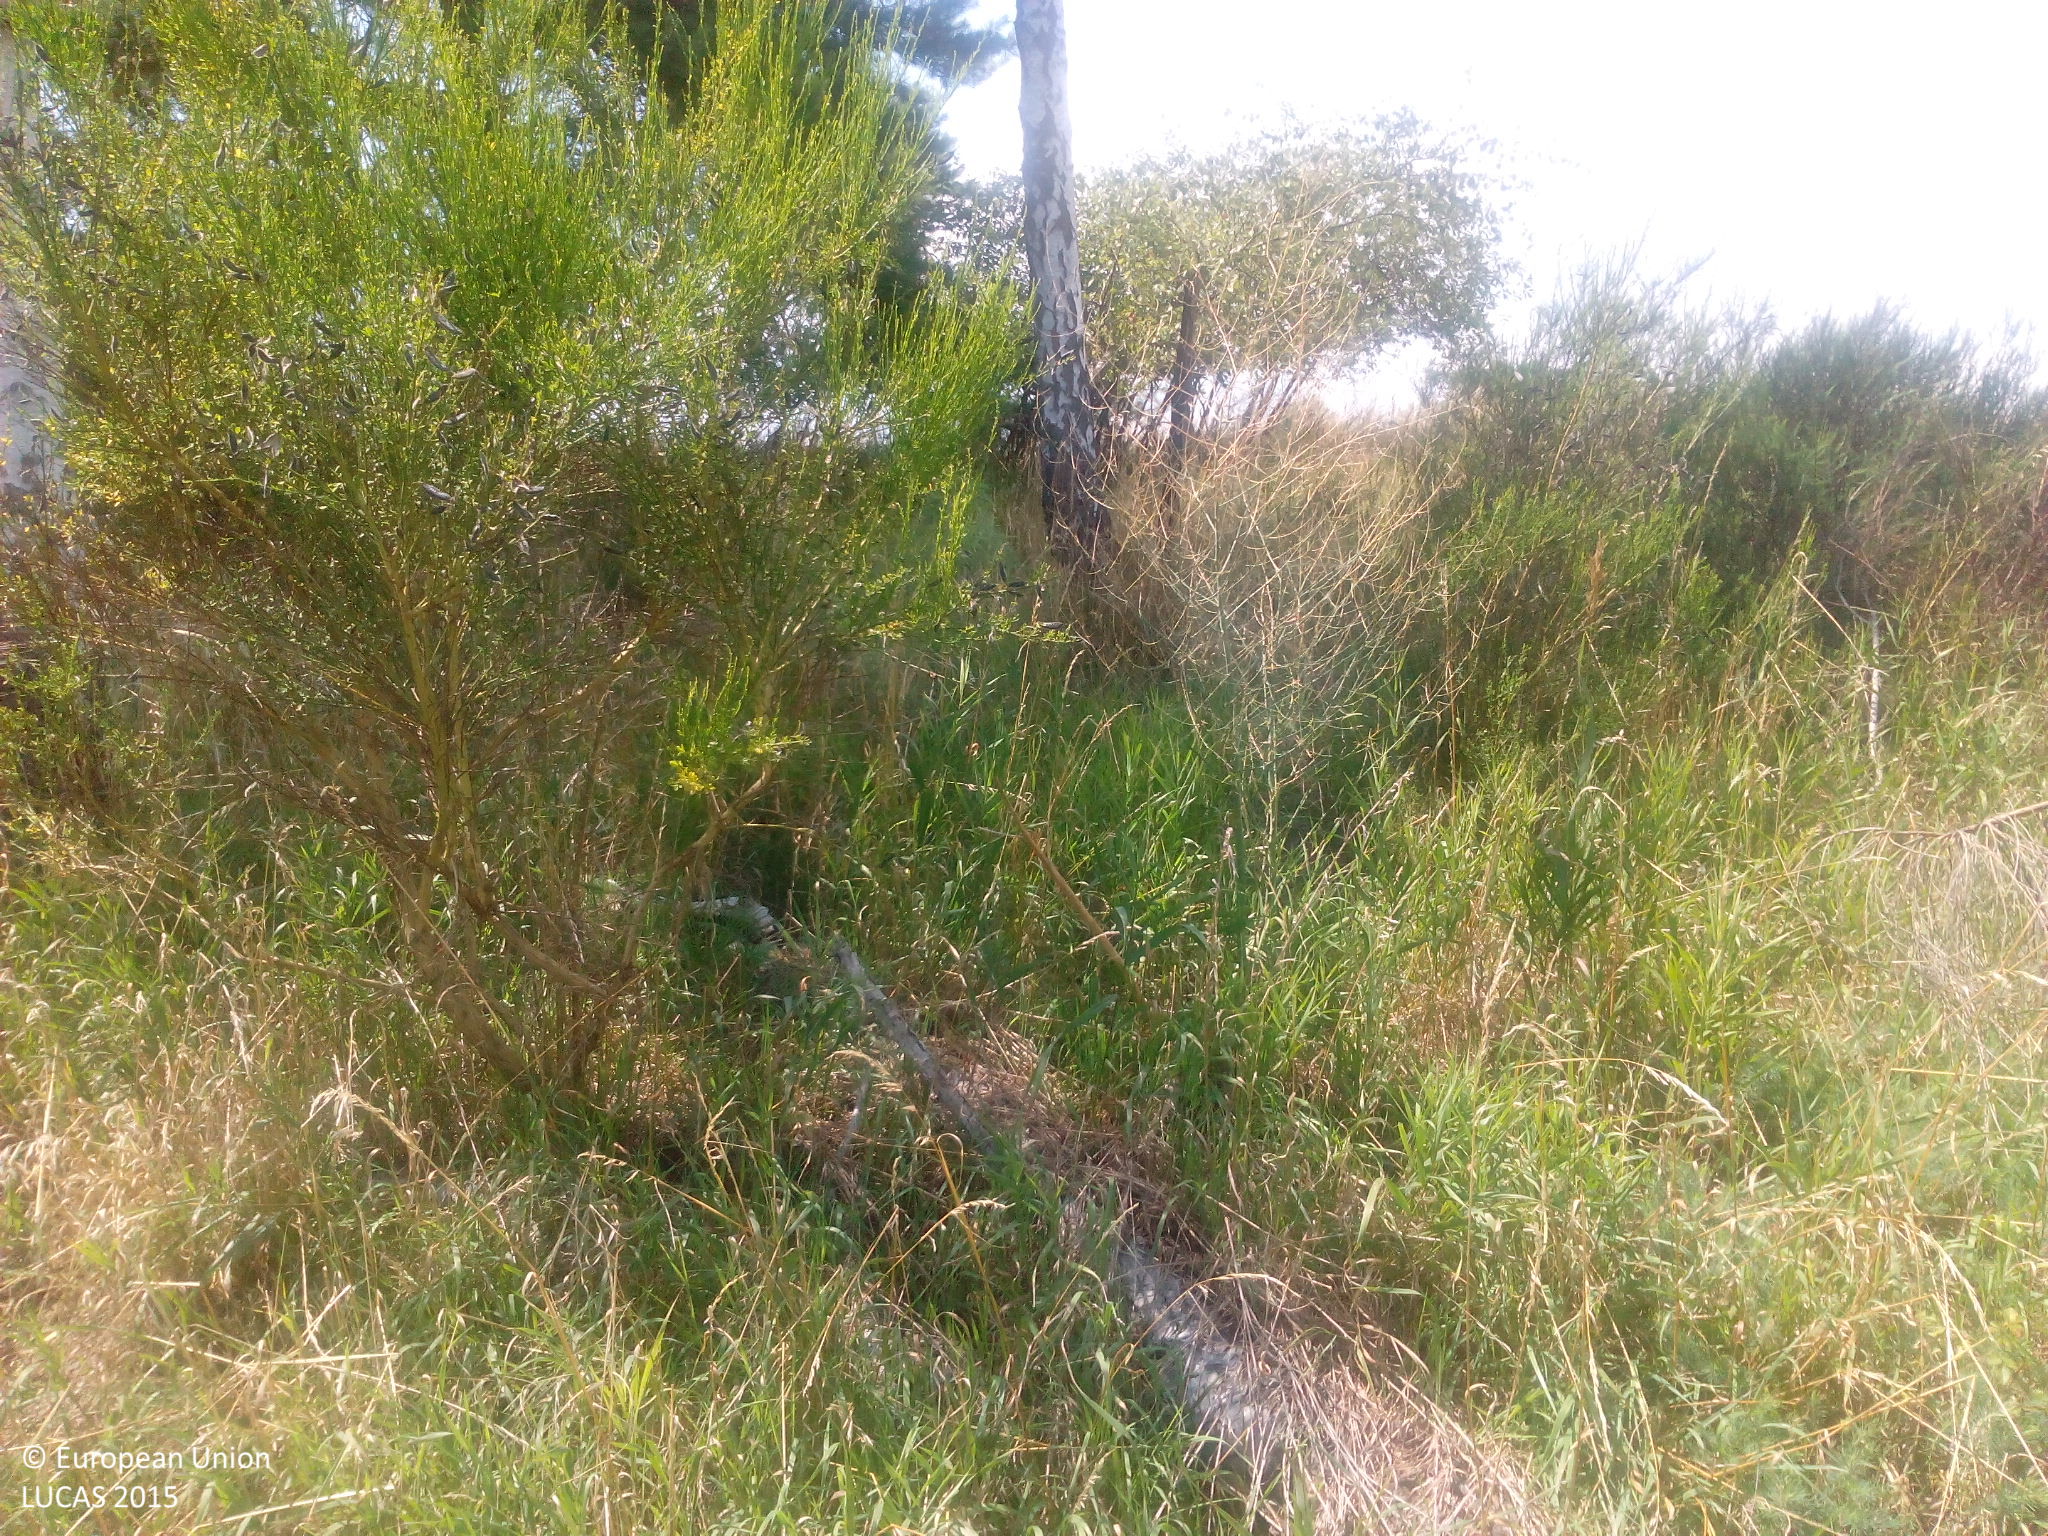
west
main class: Grassland
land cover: Grassland without tree/shrub cover
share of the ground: > 75 %
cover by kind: herbaceous plants 100 %
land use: Road transport
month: July
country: DE
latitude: 51.8858
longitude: 12.3969
